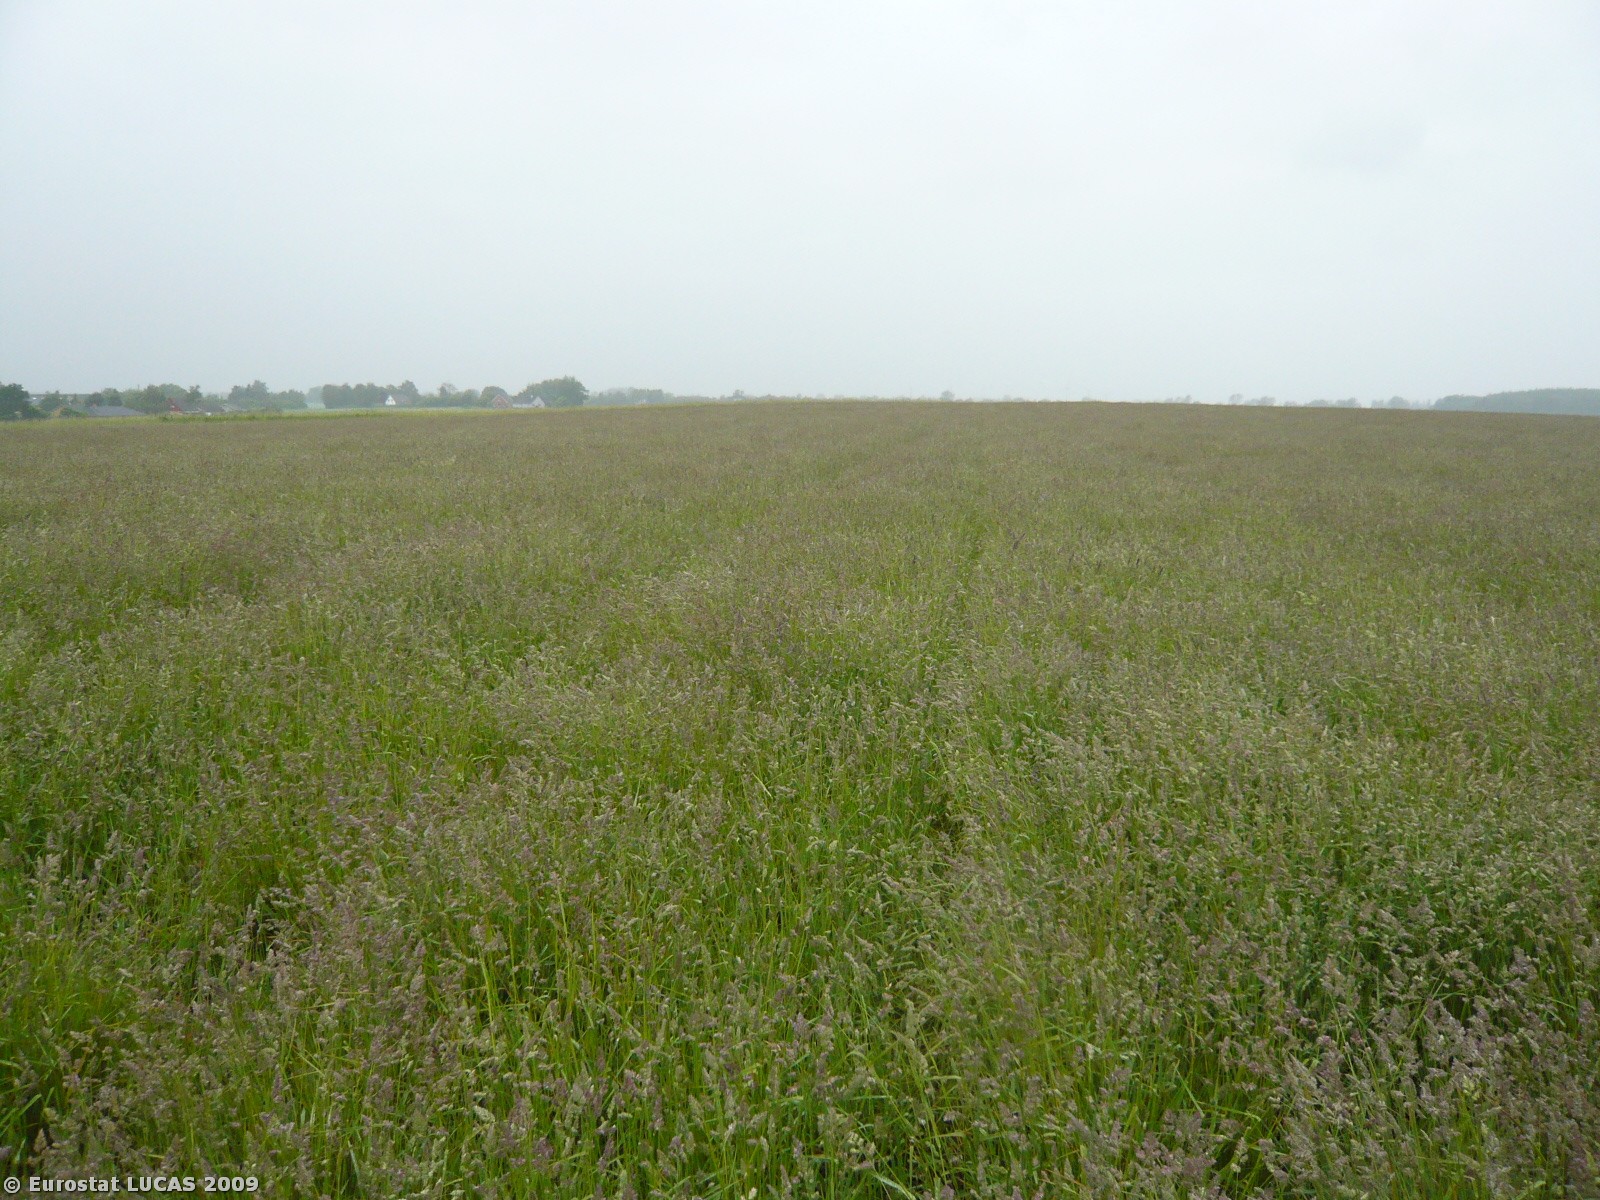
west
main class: Cropland
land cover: Temporary grasslands
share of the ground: > 75 %
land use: Agriculture (excluding fallow land and kitchen gardens)
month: June
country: DK
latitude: 54.8614
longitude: 11.8839
